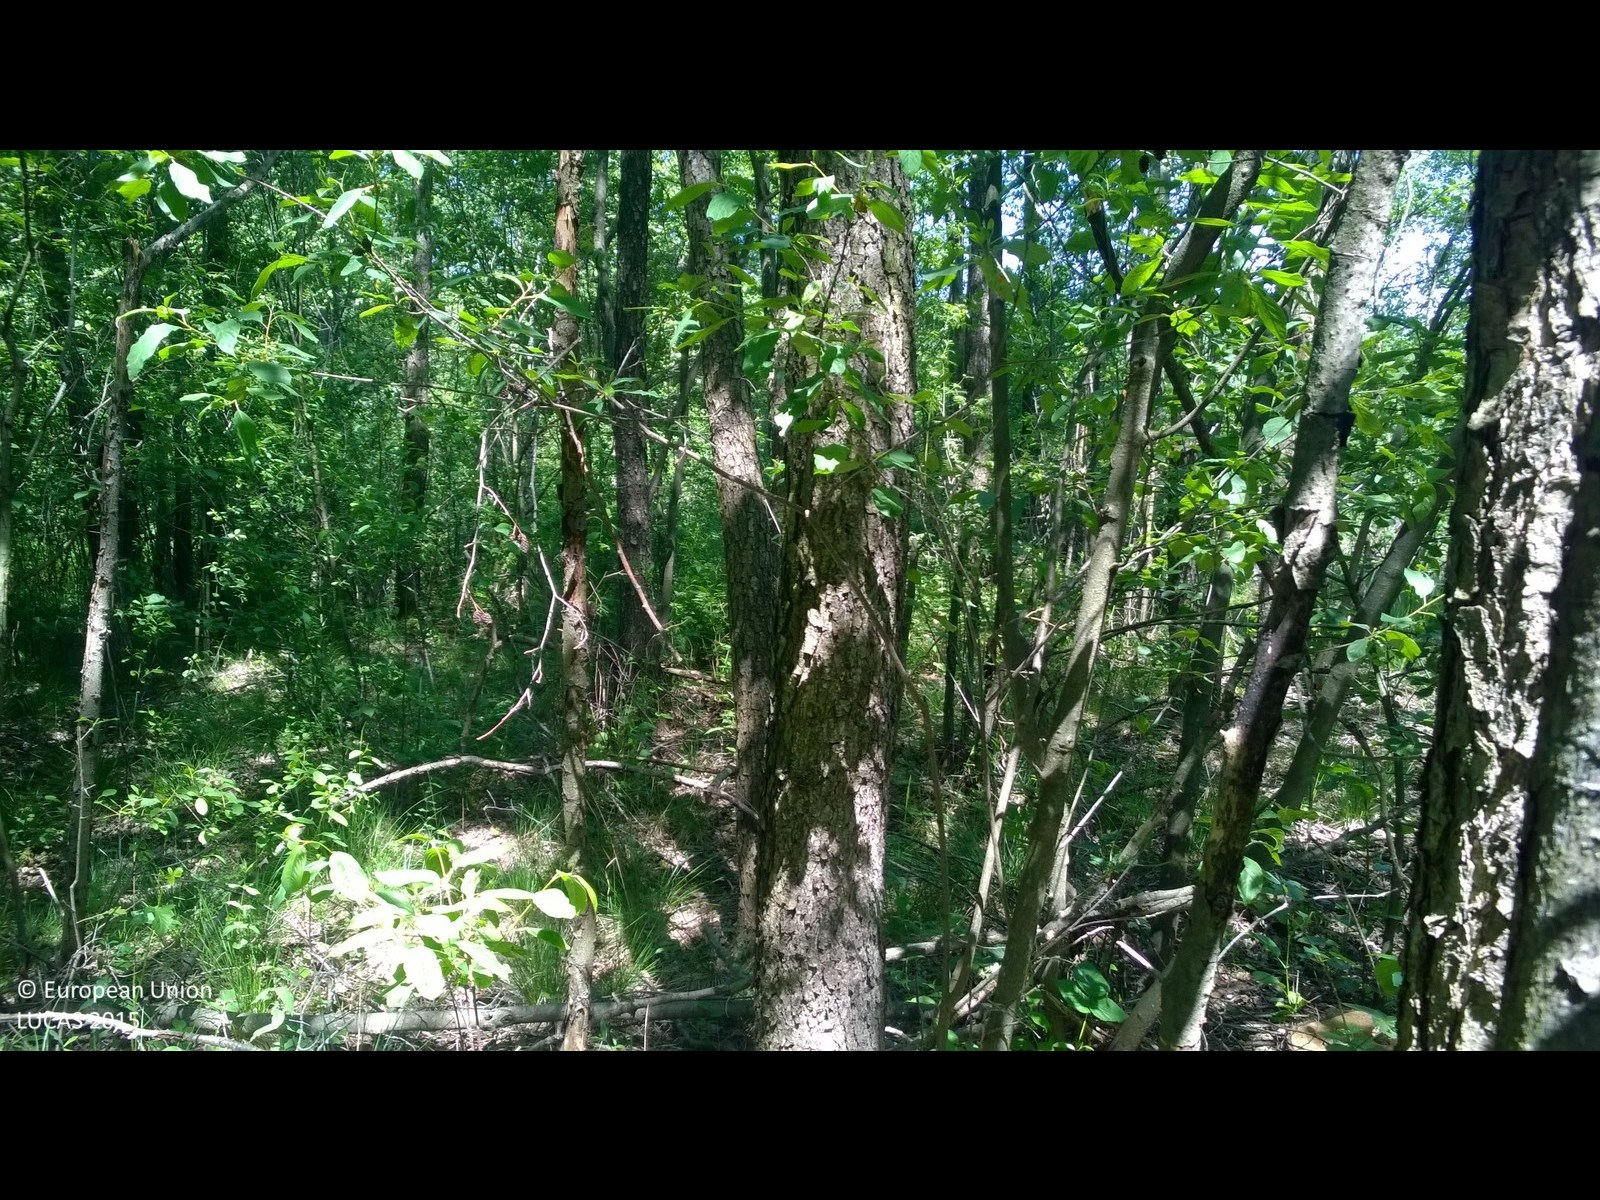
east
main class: Woodland
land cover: Broadleaved woodland
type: mesophytic deciduous forest
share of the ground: > 75 %
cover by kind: broadleaved forest trees 80 %, shrubs 15 %, herbaceous plants 5 %
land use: Forestry
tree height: > 5 m
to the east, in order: Broadleaved woodland; Grassland without tree/shrub cover; Groves; Ditches and canals; Groves; Grassland without tree/shrub cover; Ditches and canals; Groves; Grassland without tree/shrub cover; Broadleaved woodland; Grassland without tree/shrub cover; Ditches and canals; Grassland without tree/shrub cover
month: June
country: PL
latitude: 53.0038
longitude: 23.3590
